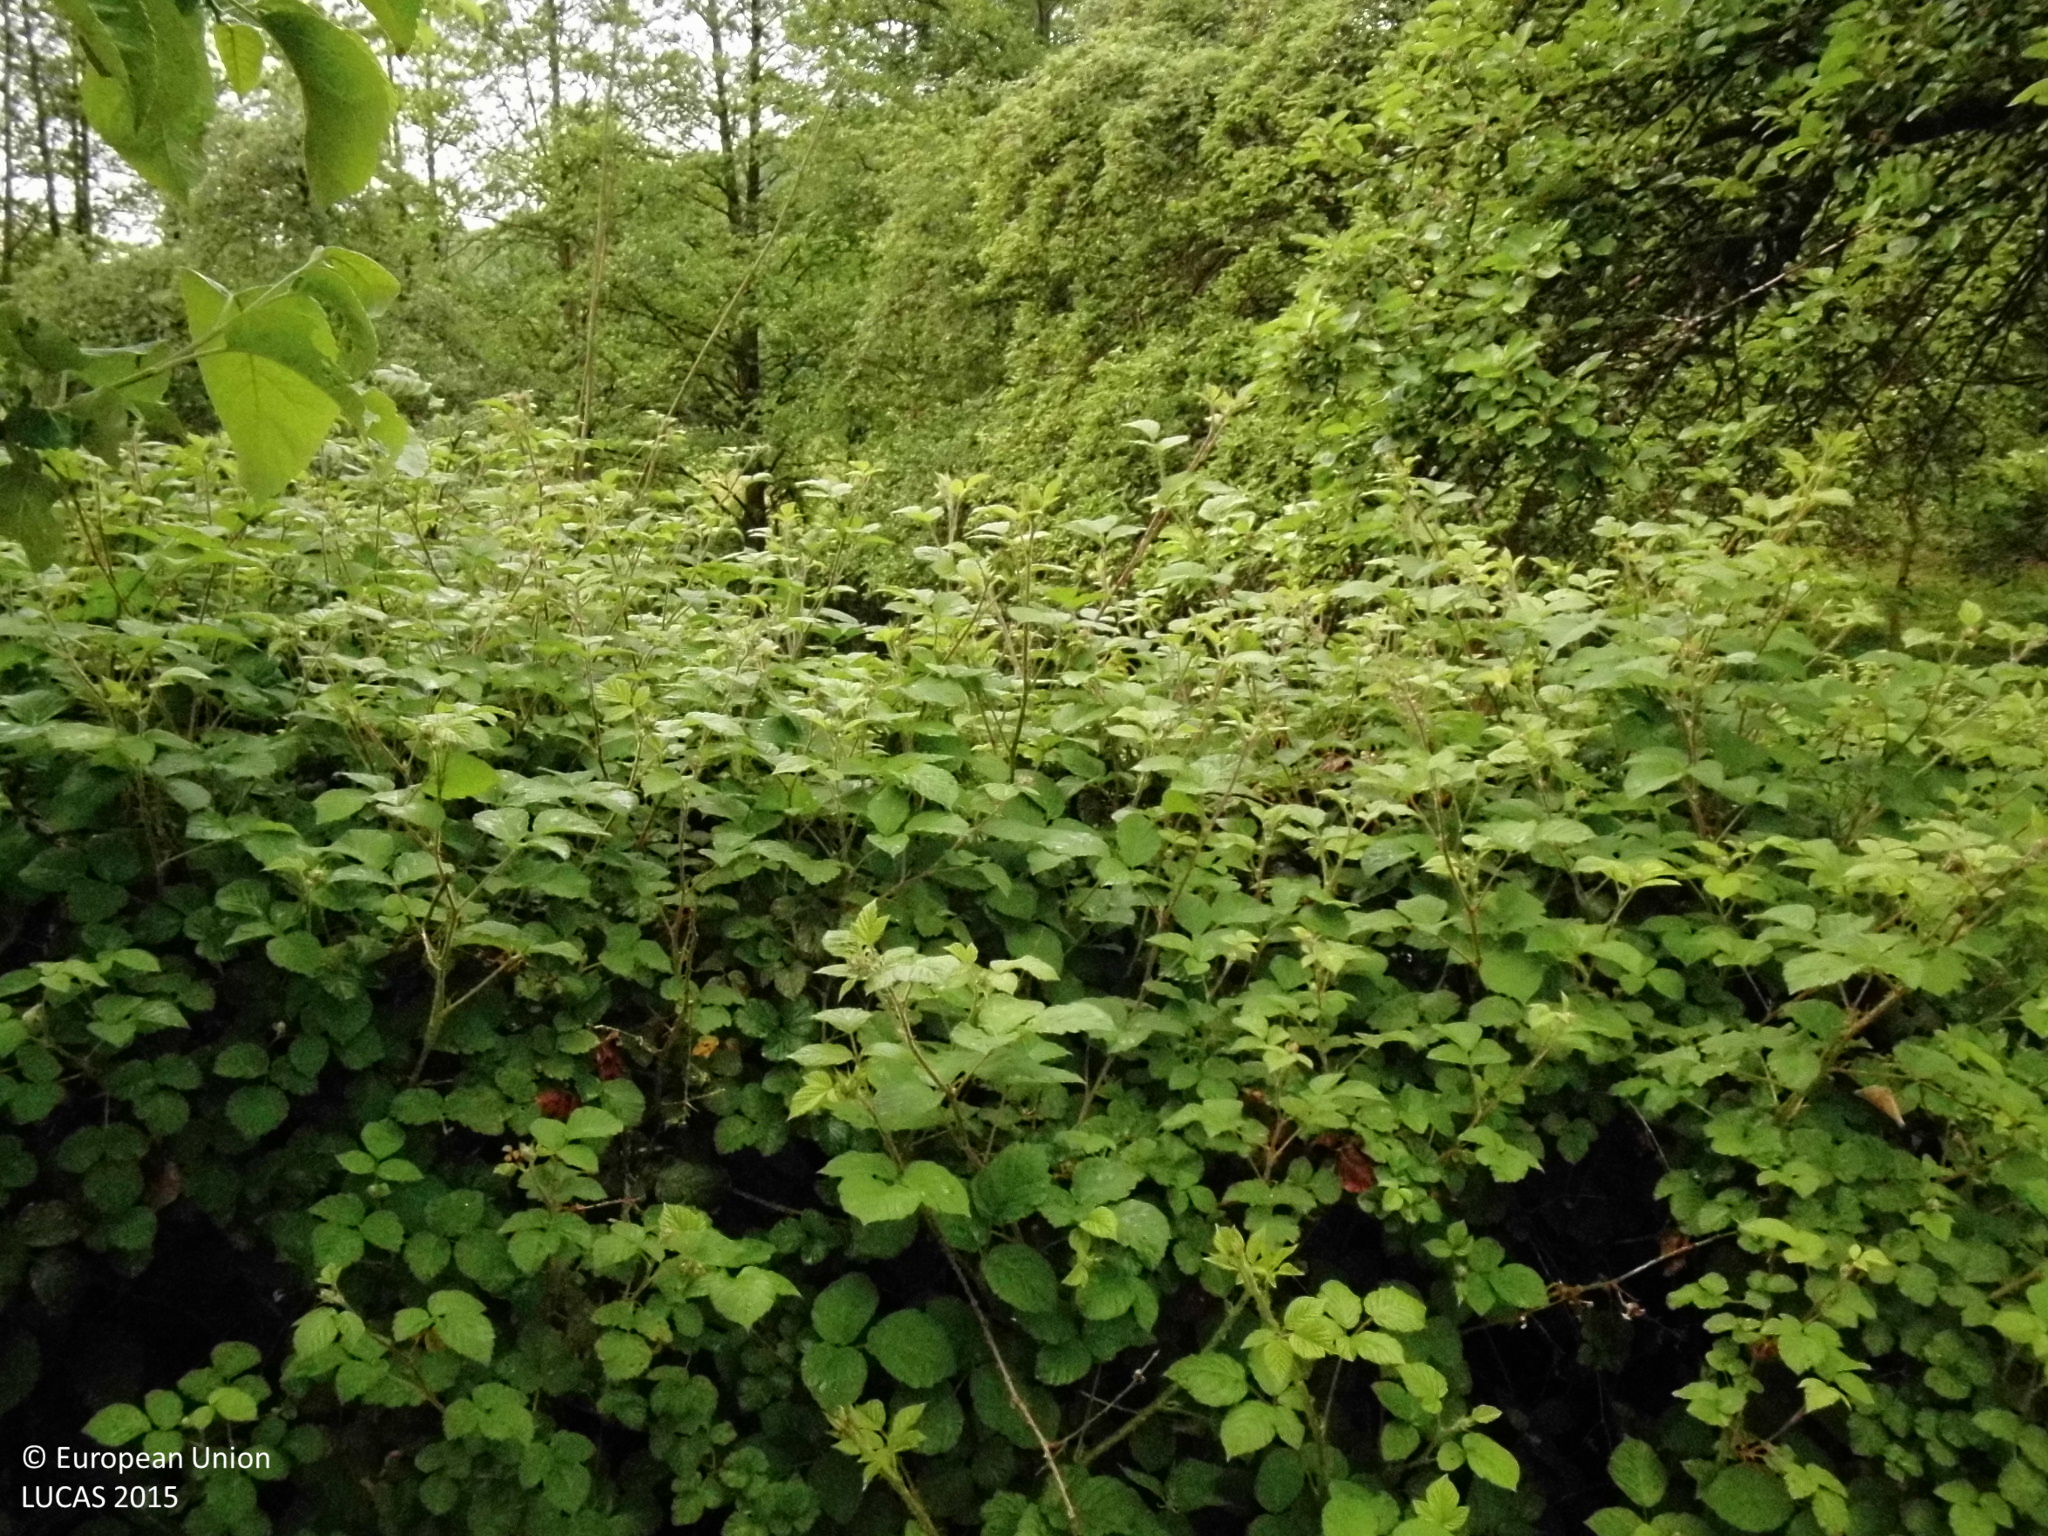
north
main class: Cropland
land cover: Apple fruit
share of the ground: 10 - 25 %
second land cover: Grassland without tree/shrub cover
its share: > 75 %
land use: Agriculture (excluding fallow land and kitchen gardens)
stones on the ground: 10 - 25 %
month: May
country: DE
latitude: 50.7317
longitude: 7.4642
